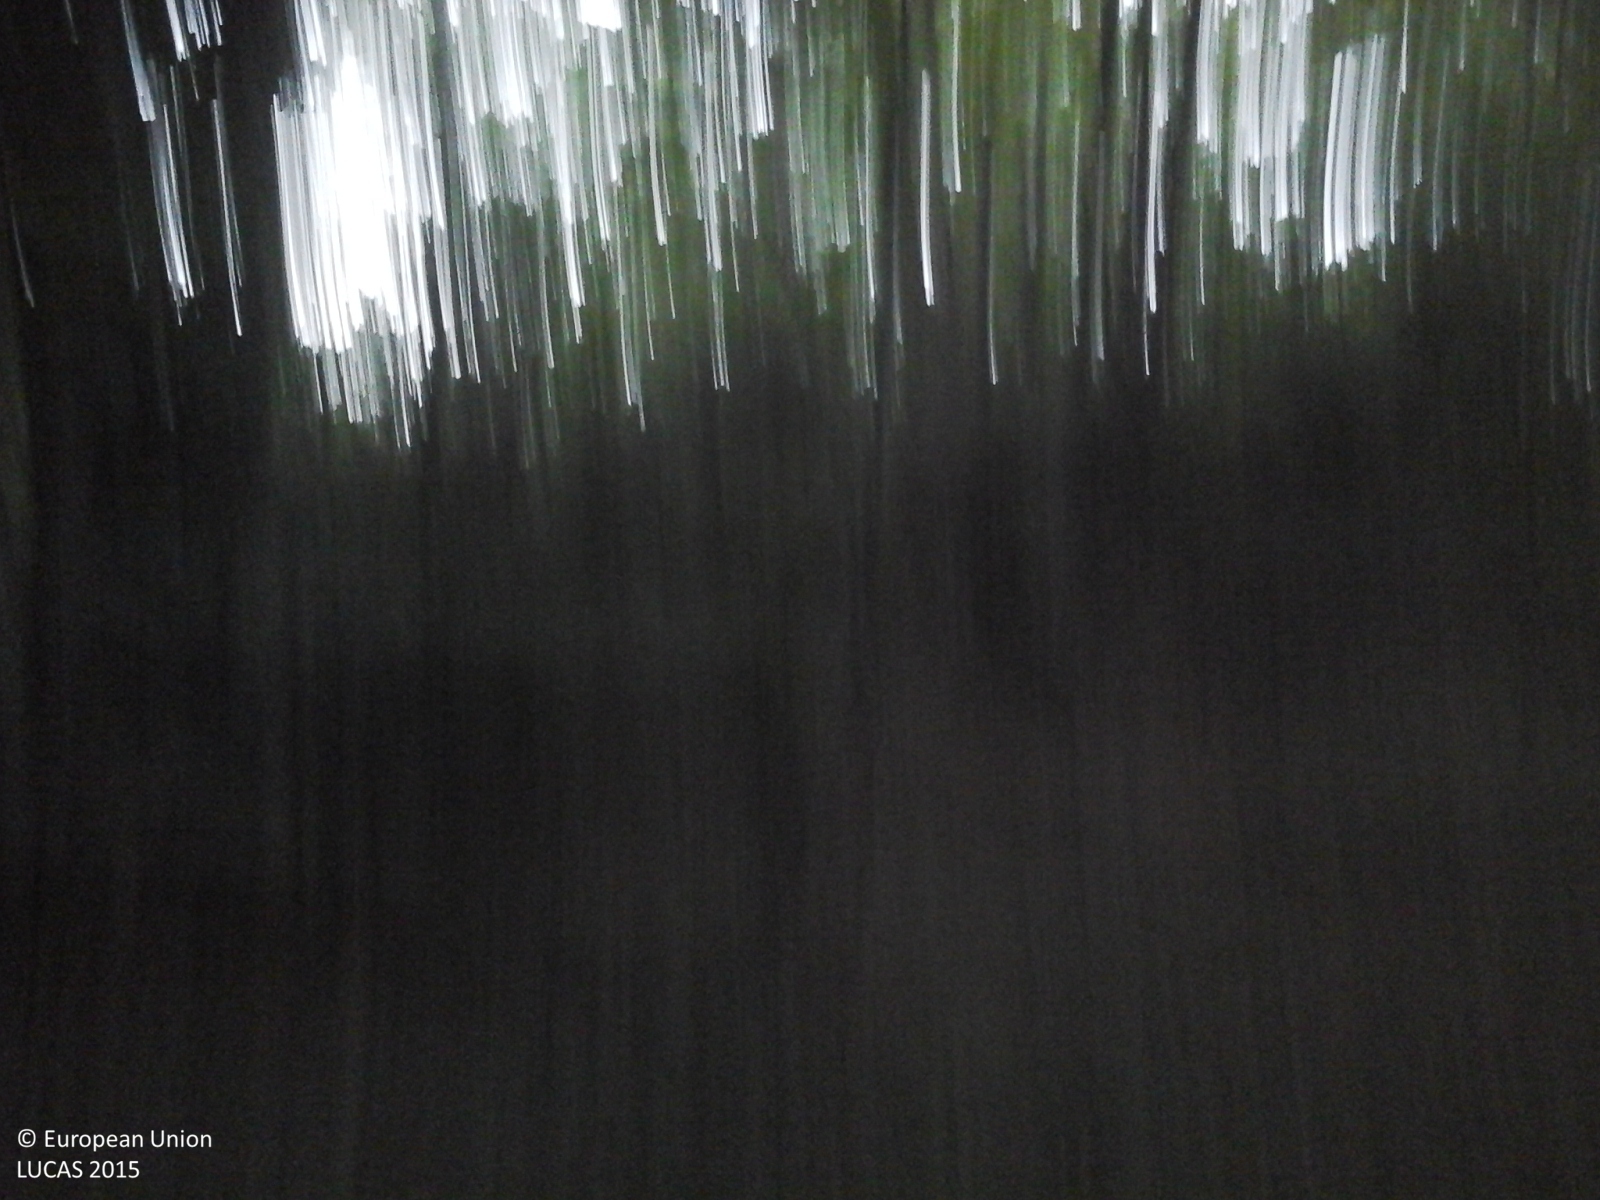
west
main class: Woodland
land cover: Broadleaved woodland
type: thermophilous deciduous forest
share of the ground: > 75 %
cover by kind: broadleaved forest trees 80 %, shrubs 10 %, herbaceous plants 10 %
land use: Semi-natural and natural areas not in use
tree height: > 5 m
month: September
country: IT
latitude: 44.2278
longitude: 8.2639
